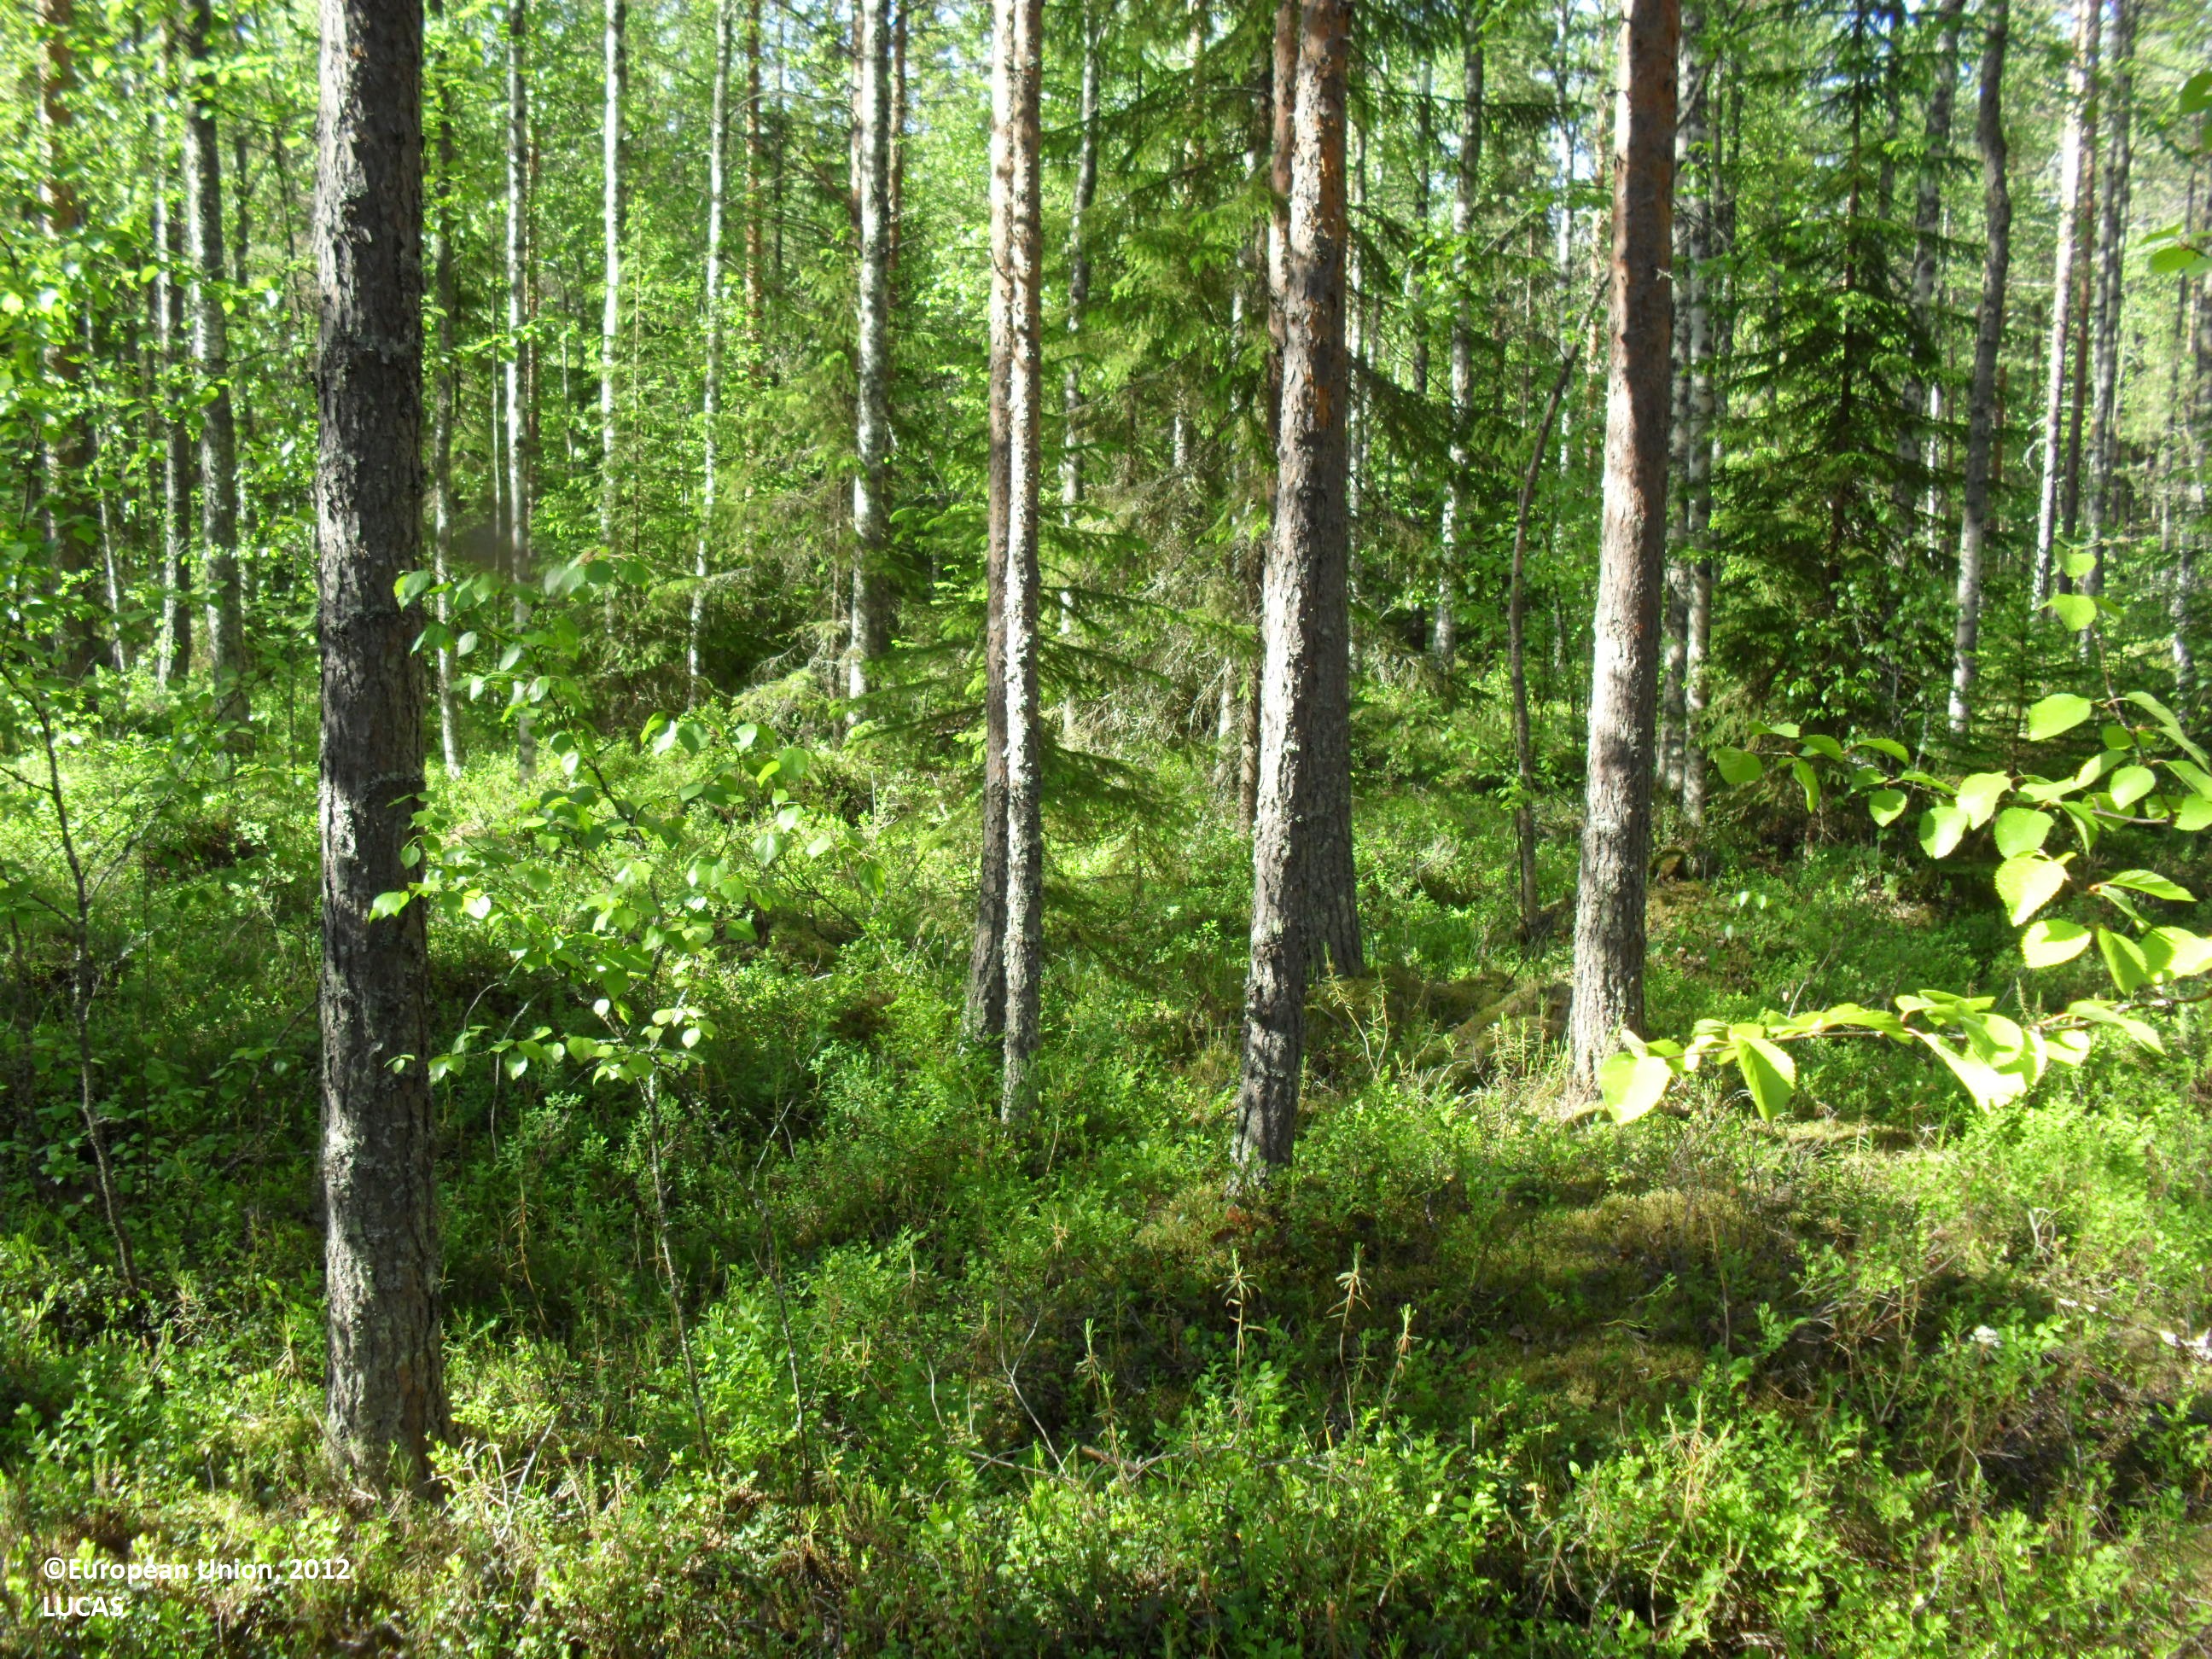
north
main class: Woodland
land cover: Pine dominated mixed woodland
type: boreal forest
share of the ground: 50 - 75 %
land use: Forestry
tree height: > 5 m
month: June
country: FI
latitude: 62.9482
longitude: 23.3684
